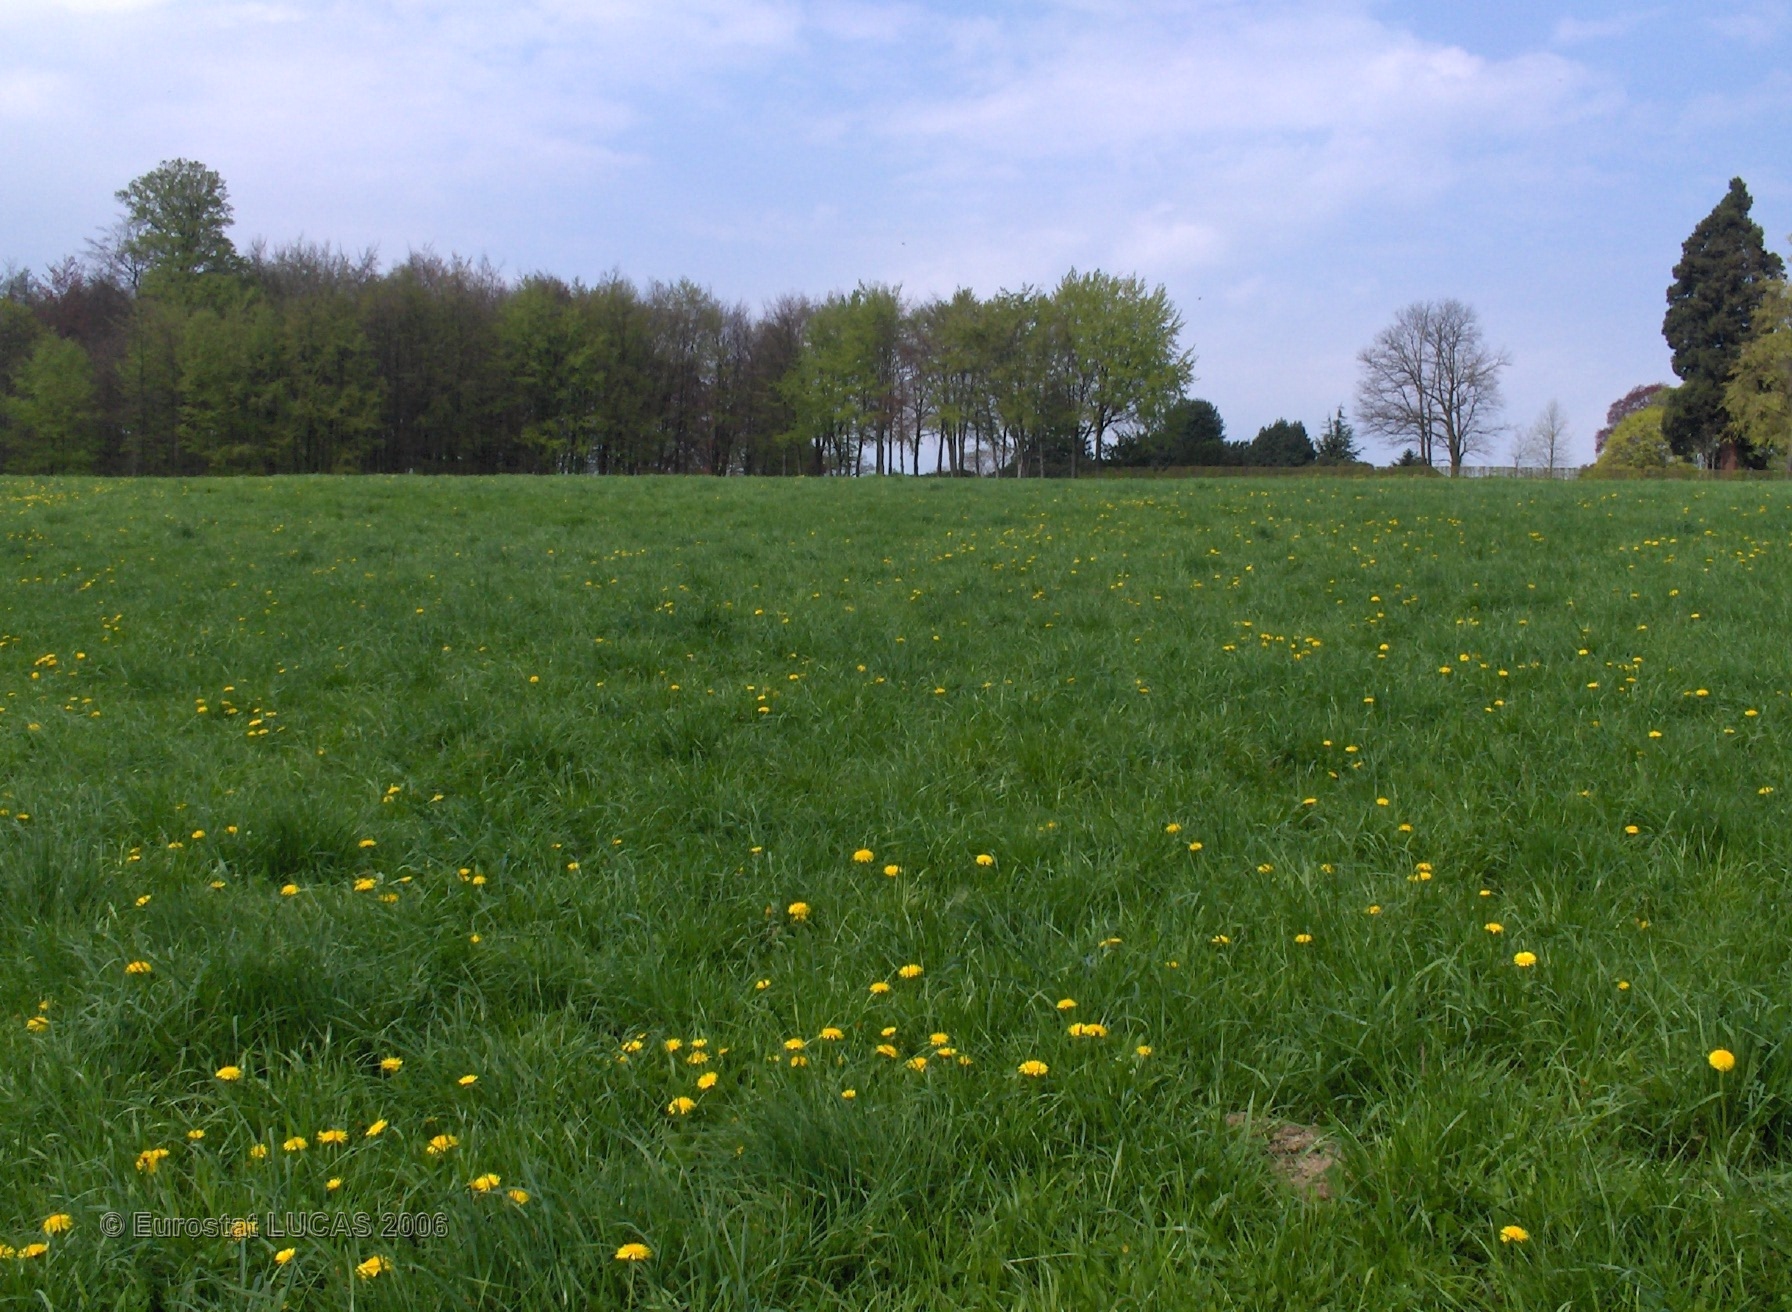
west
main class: Grassland
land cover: Grassland without tree/shrub cover
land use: Agriculture (excluding fallow land and kitchen gardens)
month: May
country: BE
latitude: 50.3212
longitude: 5.2927
